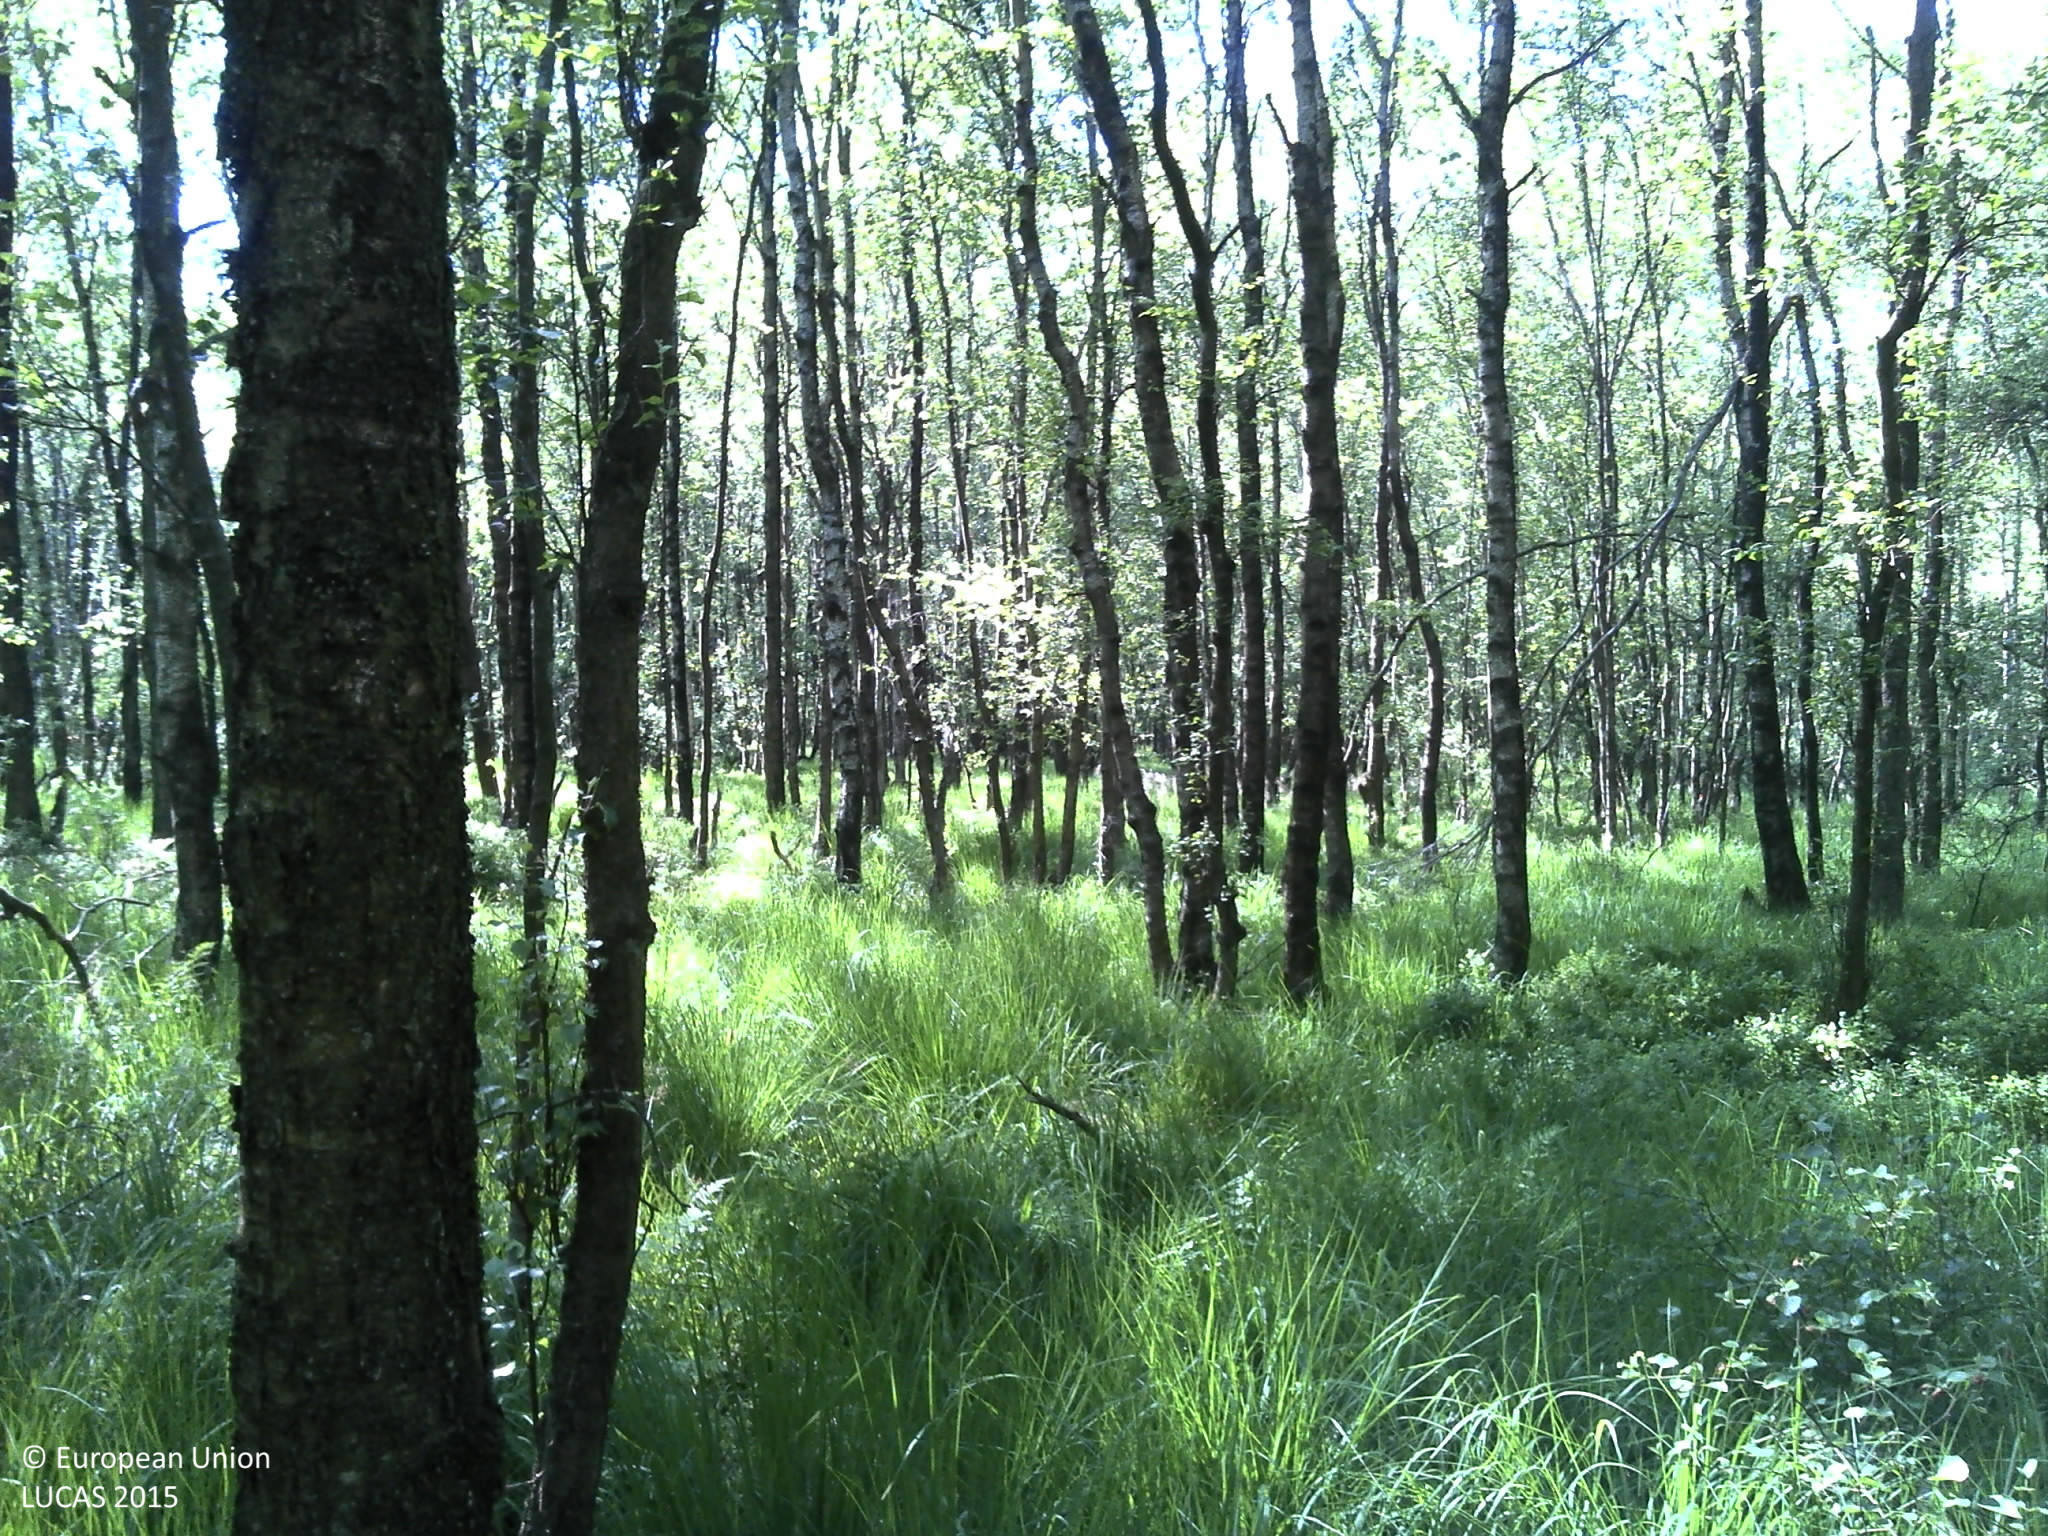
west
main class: Woodland
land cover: Broadleaved woodland
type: non-riverine alder, birch or aspen forest
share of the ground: 50 - 75 %
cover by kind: broadleaved forest trees 60 %, herbaceous plants 35 %, lichens and mosses 5 %
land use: Forestry
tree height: > 5 m
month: June
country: FR
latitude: 49.9741
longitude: 4.7679
